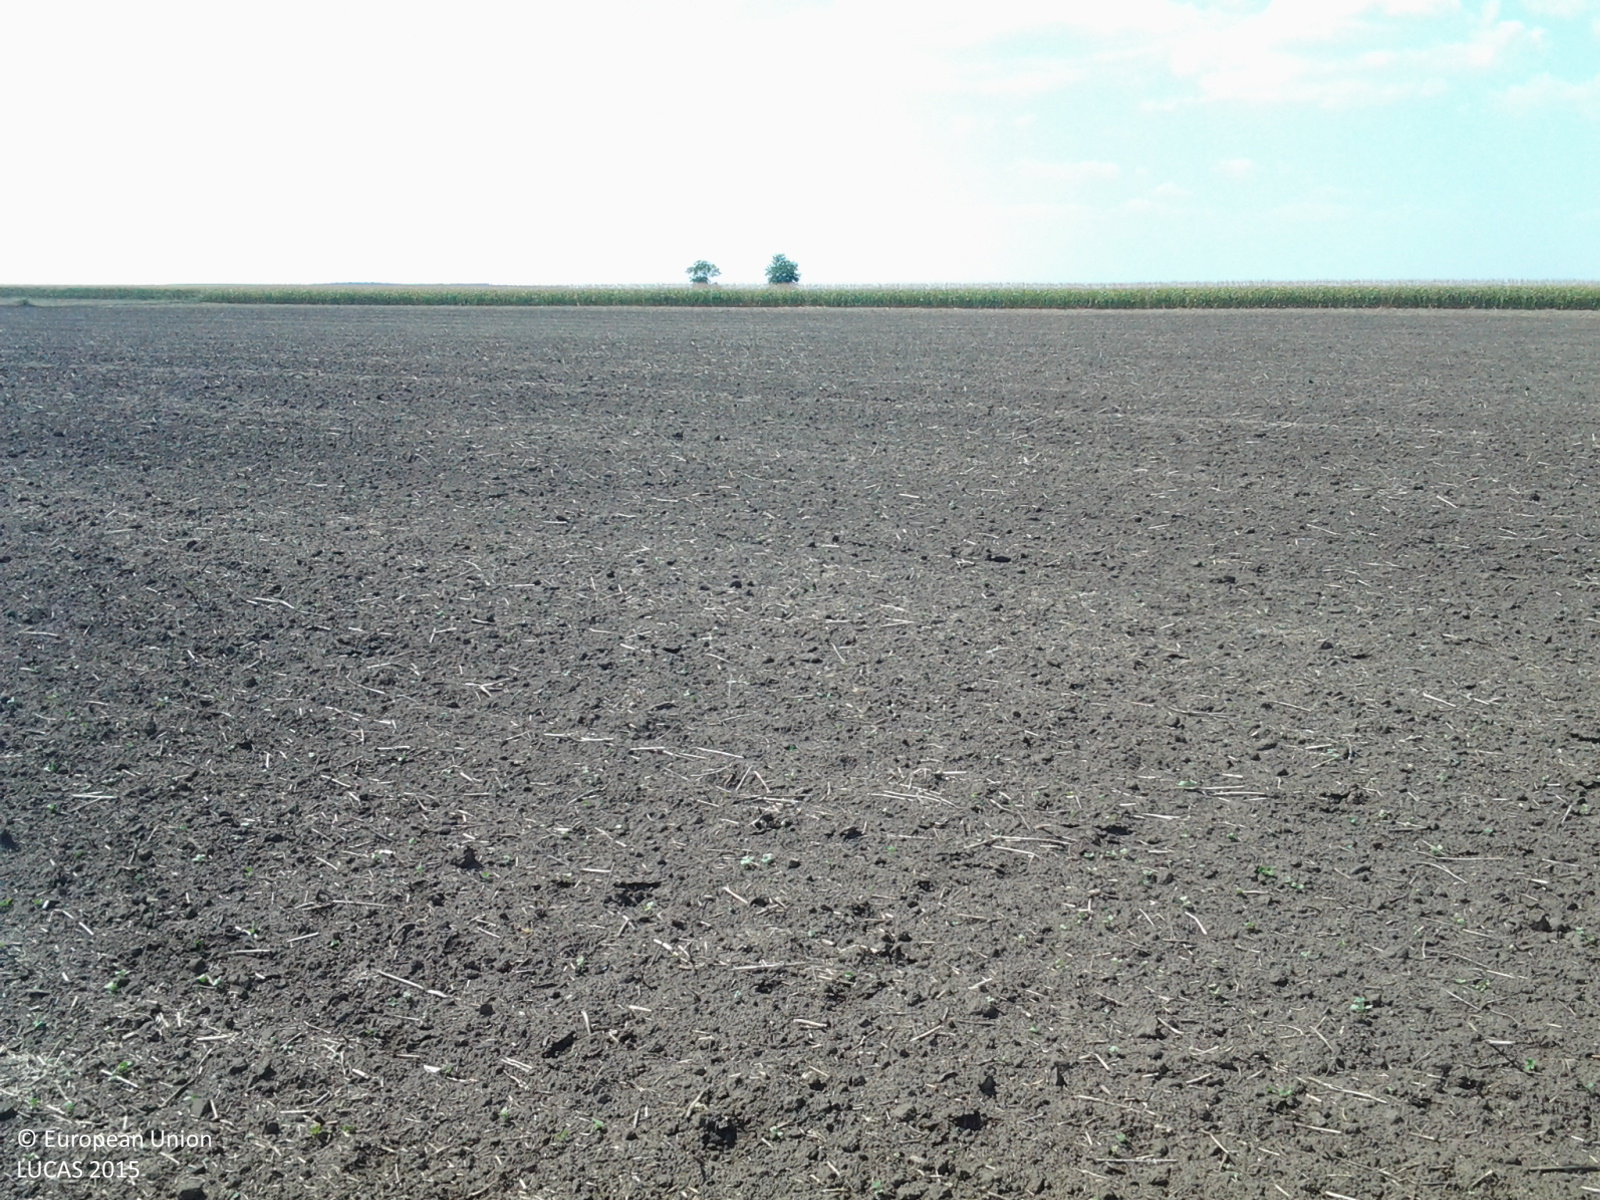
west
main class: Cropland
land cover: Rape and turnip rape
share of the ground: < 10 %
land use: Agriculture (excluding fallow land and kitchen gardens)
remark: Harvested field
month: August
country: HU
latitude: 47.3218
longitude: 19.7207
